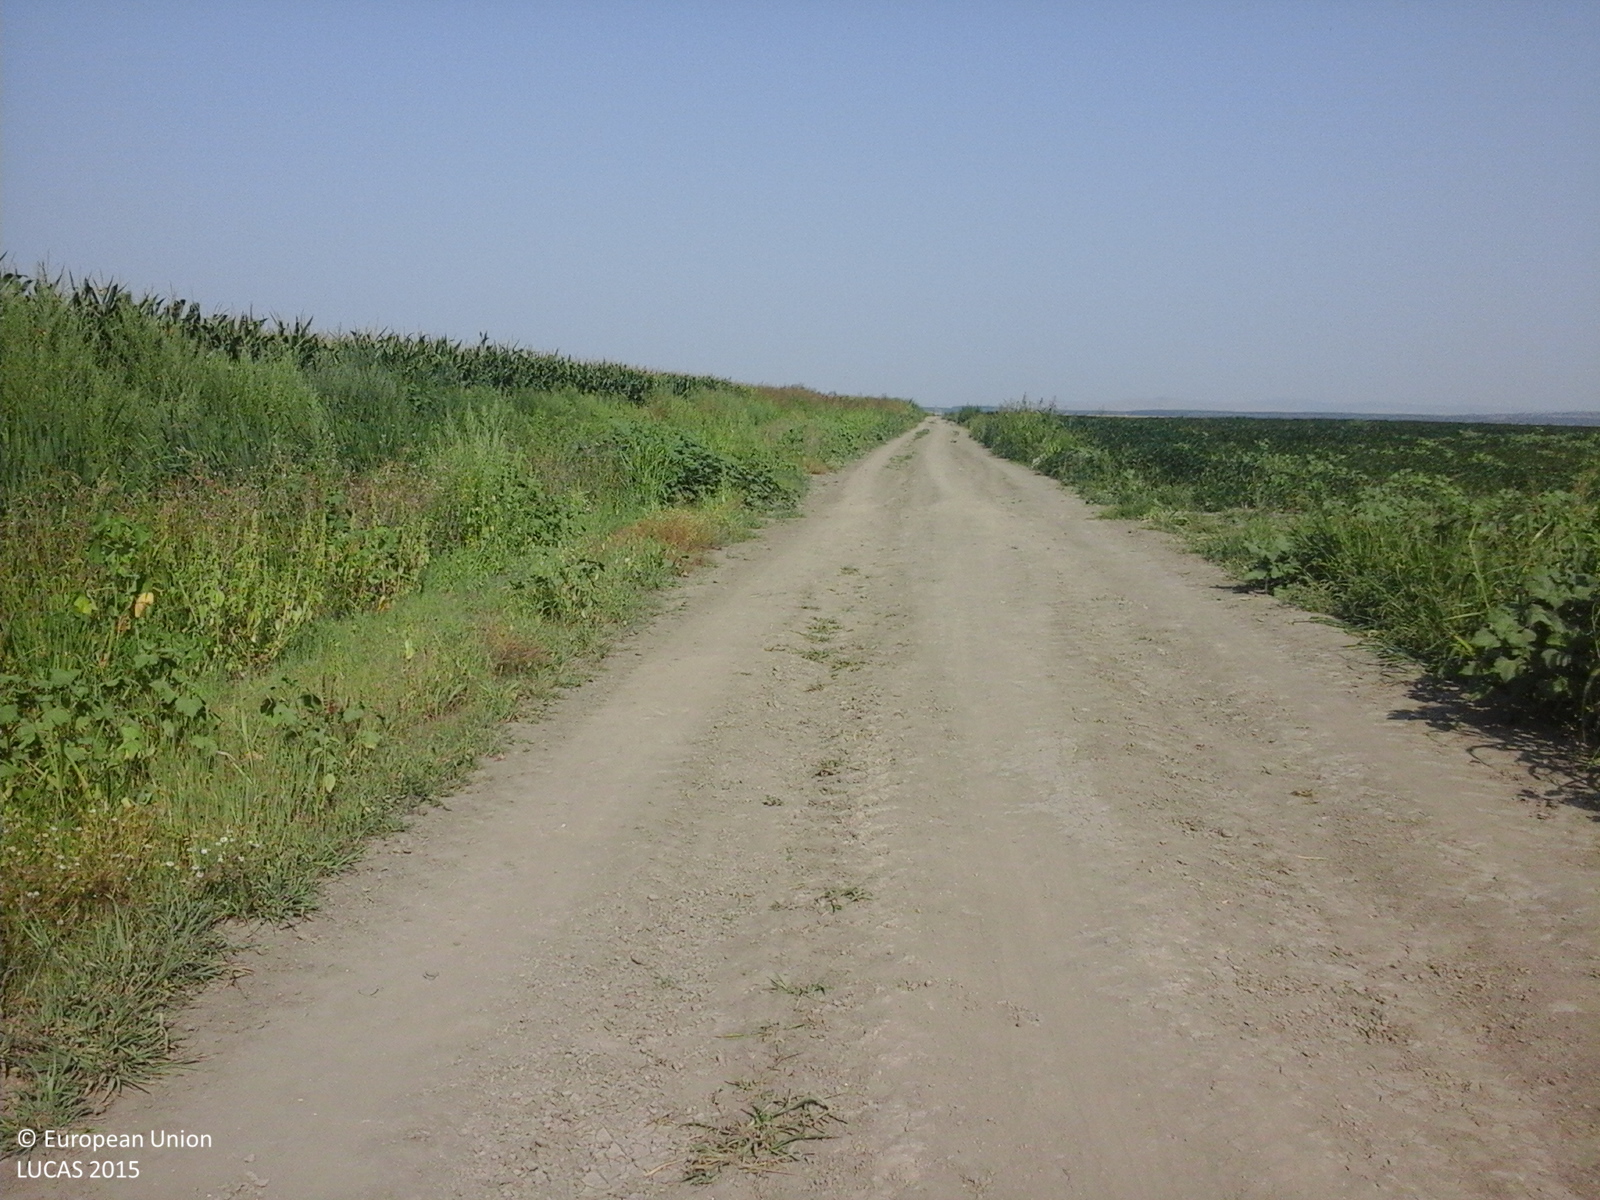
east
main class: Cropland
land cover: Maize
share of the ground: > 75 %
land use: Agriculture (excluding fallow land and kitchen gardens)
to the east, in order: Maize; Grass margins; Tracks; Spontaneously vegetated surfaces; Sunflower
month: August
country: RO
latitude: 45.0384
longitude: 28.0519
